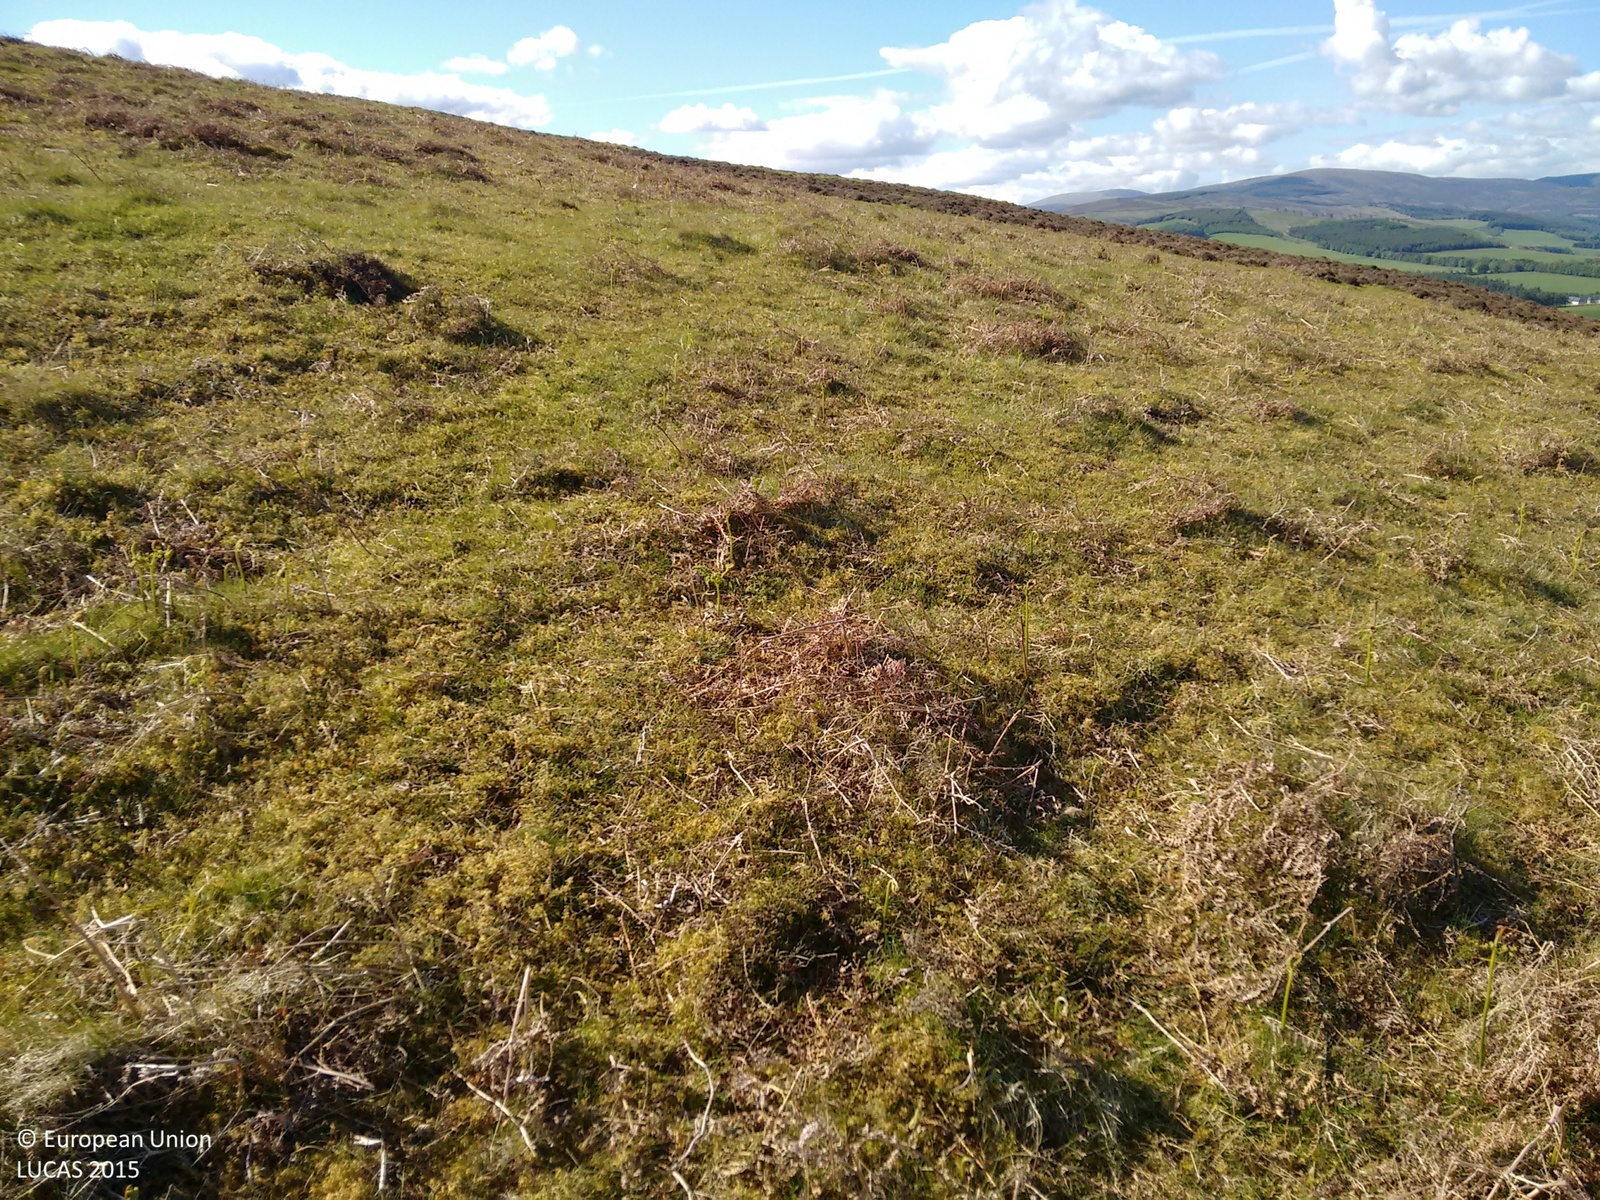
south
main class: Grassland
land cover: Grassland without tree/shrub cover
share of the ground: > 75 %
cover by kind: herbaceous plants 90 %, lichens and mosses 10 %
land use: Agriculture (excluding fallow land and kitchen gardens)
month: June
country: GB
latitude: 55.6607
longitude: -3.2511
